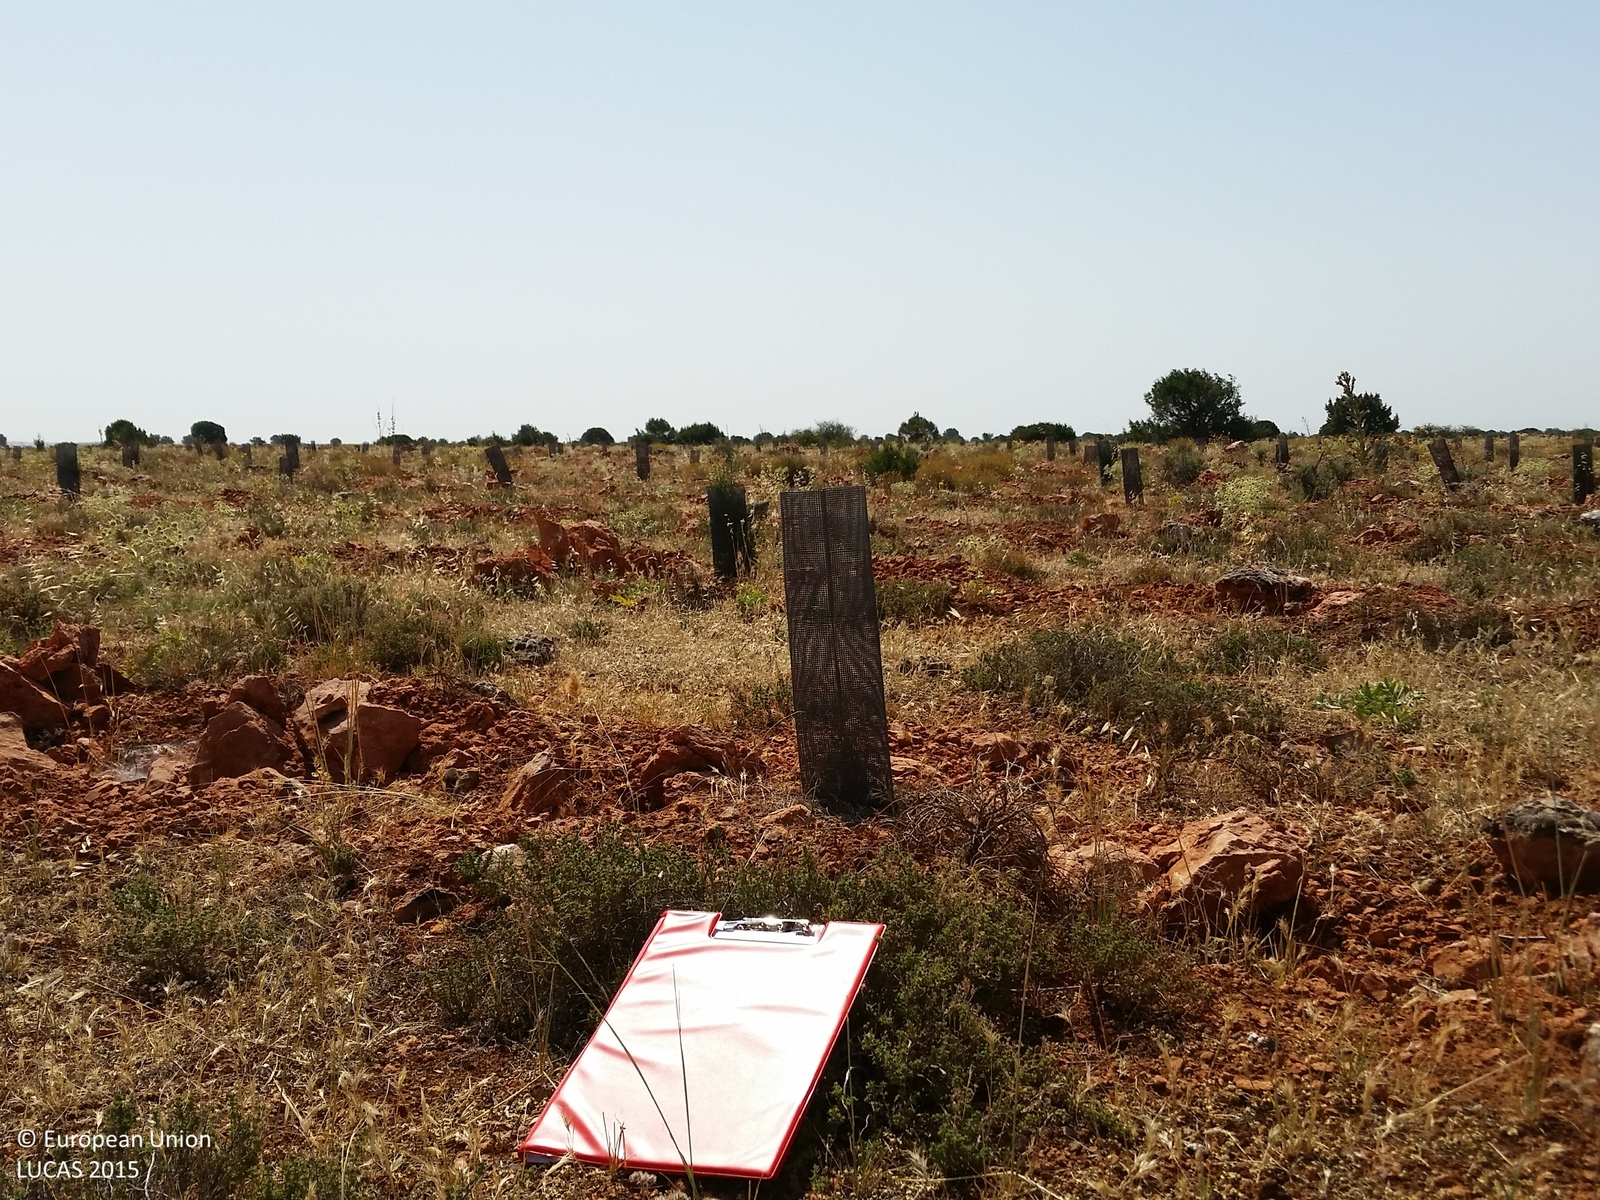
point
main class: Woodland
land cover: Broadleaved woodland
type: broadleaved evergreen forest
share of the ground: 10 - 25 %
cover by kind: unconsolidated bare surface 40 %, broadleaved forest trees 15 %, shrubs 15 %, herbaceous plants 15 %, consolidated bare surface 15 %
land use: Forestry
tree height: < 5 m
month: July
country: ES
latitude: 38.8985
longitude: -2.6311
